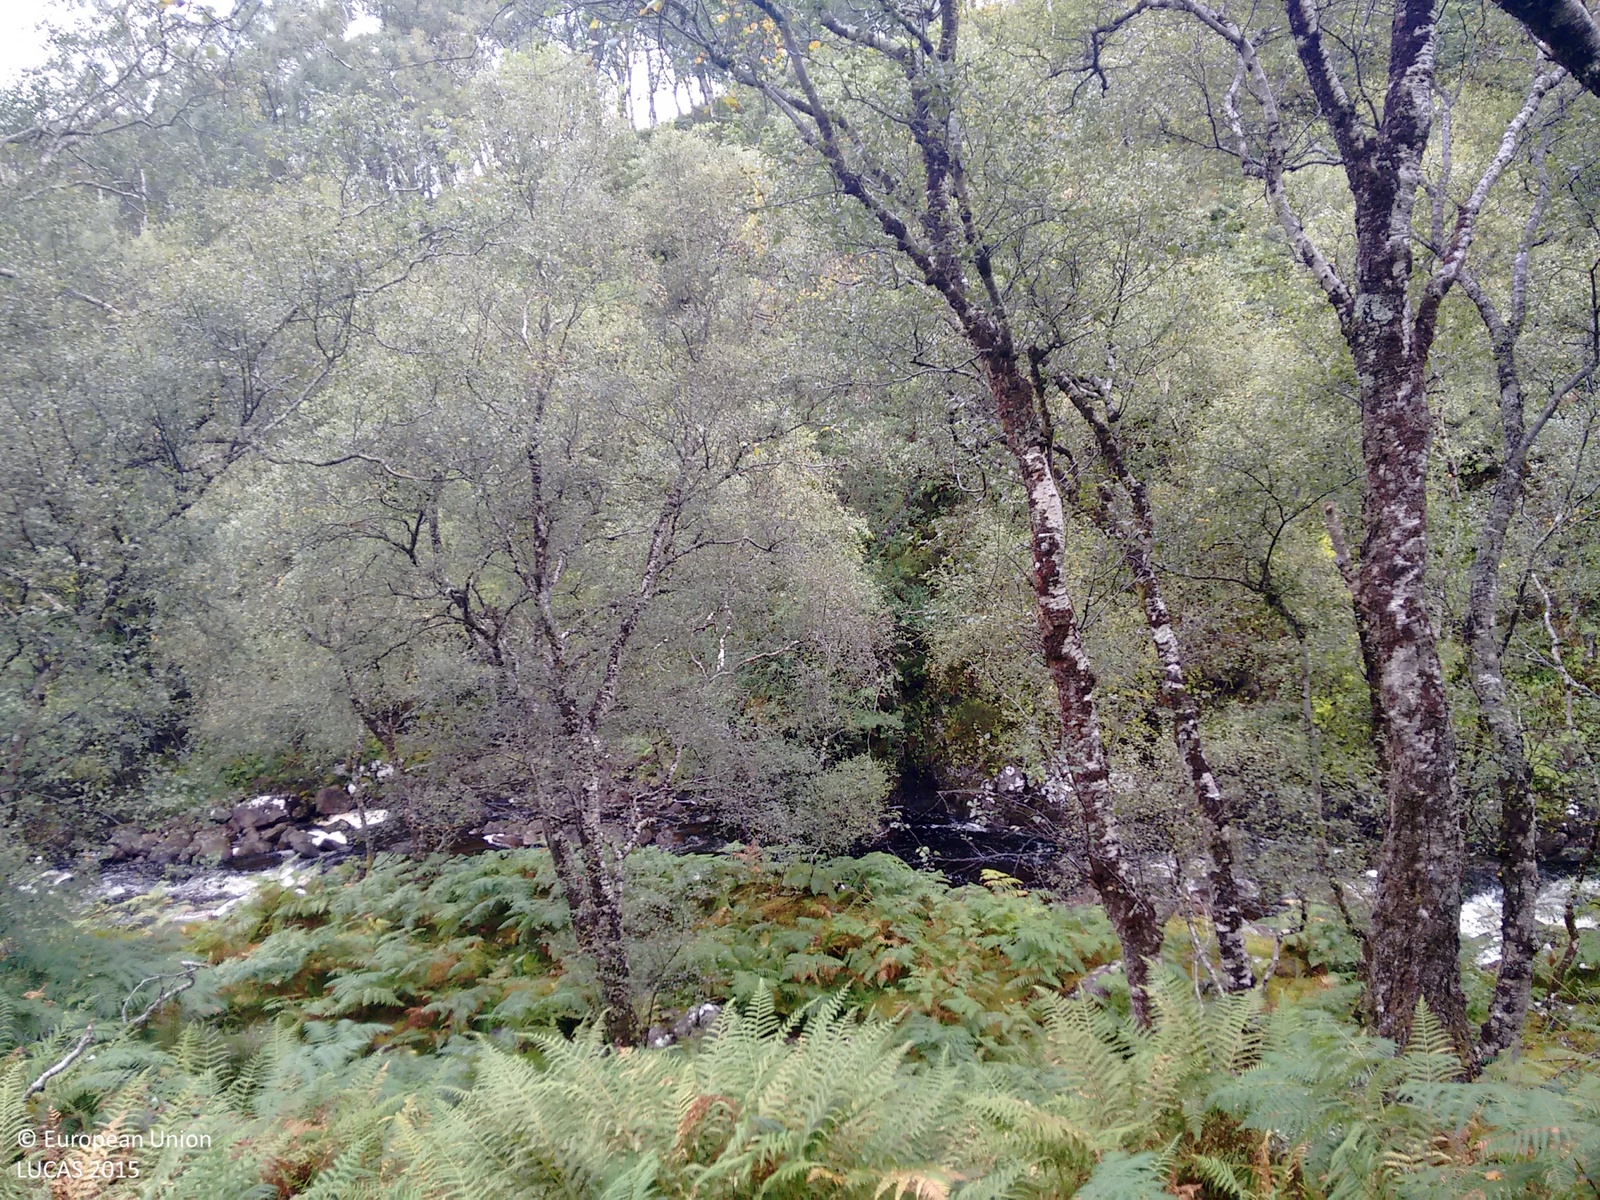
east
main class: Woodland
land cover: Broadleaved woodland
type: floodplain forest
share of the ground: > 75 %
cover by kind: broadleaved forest trees 90 %, herbaceous plants 10 %
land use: Agriculture (excluding fallow land and kitchen gardens)
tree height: > 5 m
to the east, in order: Broadleaved woodland; Inland fresh running water; Broadleaved woodland; Shrubland without tree cover
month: September
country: GB
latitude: 57.5268
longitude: -5.7007
